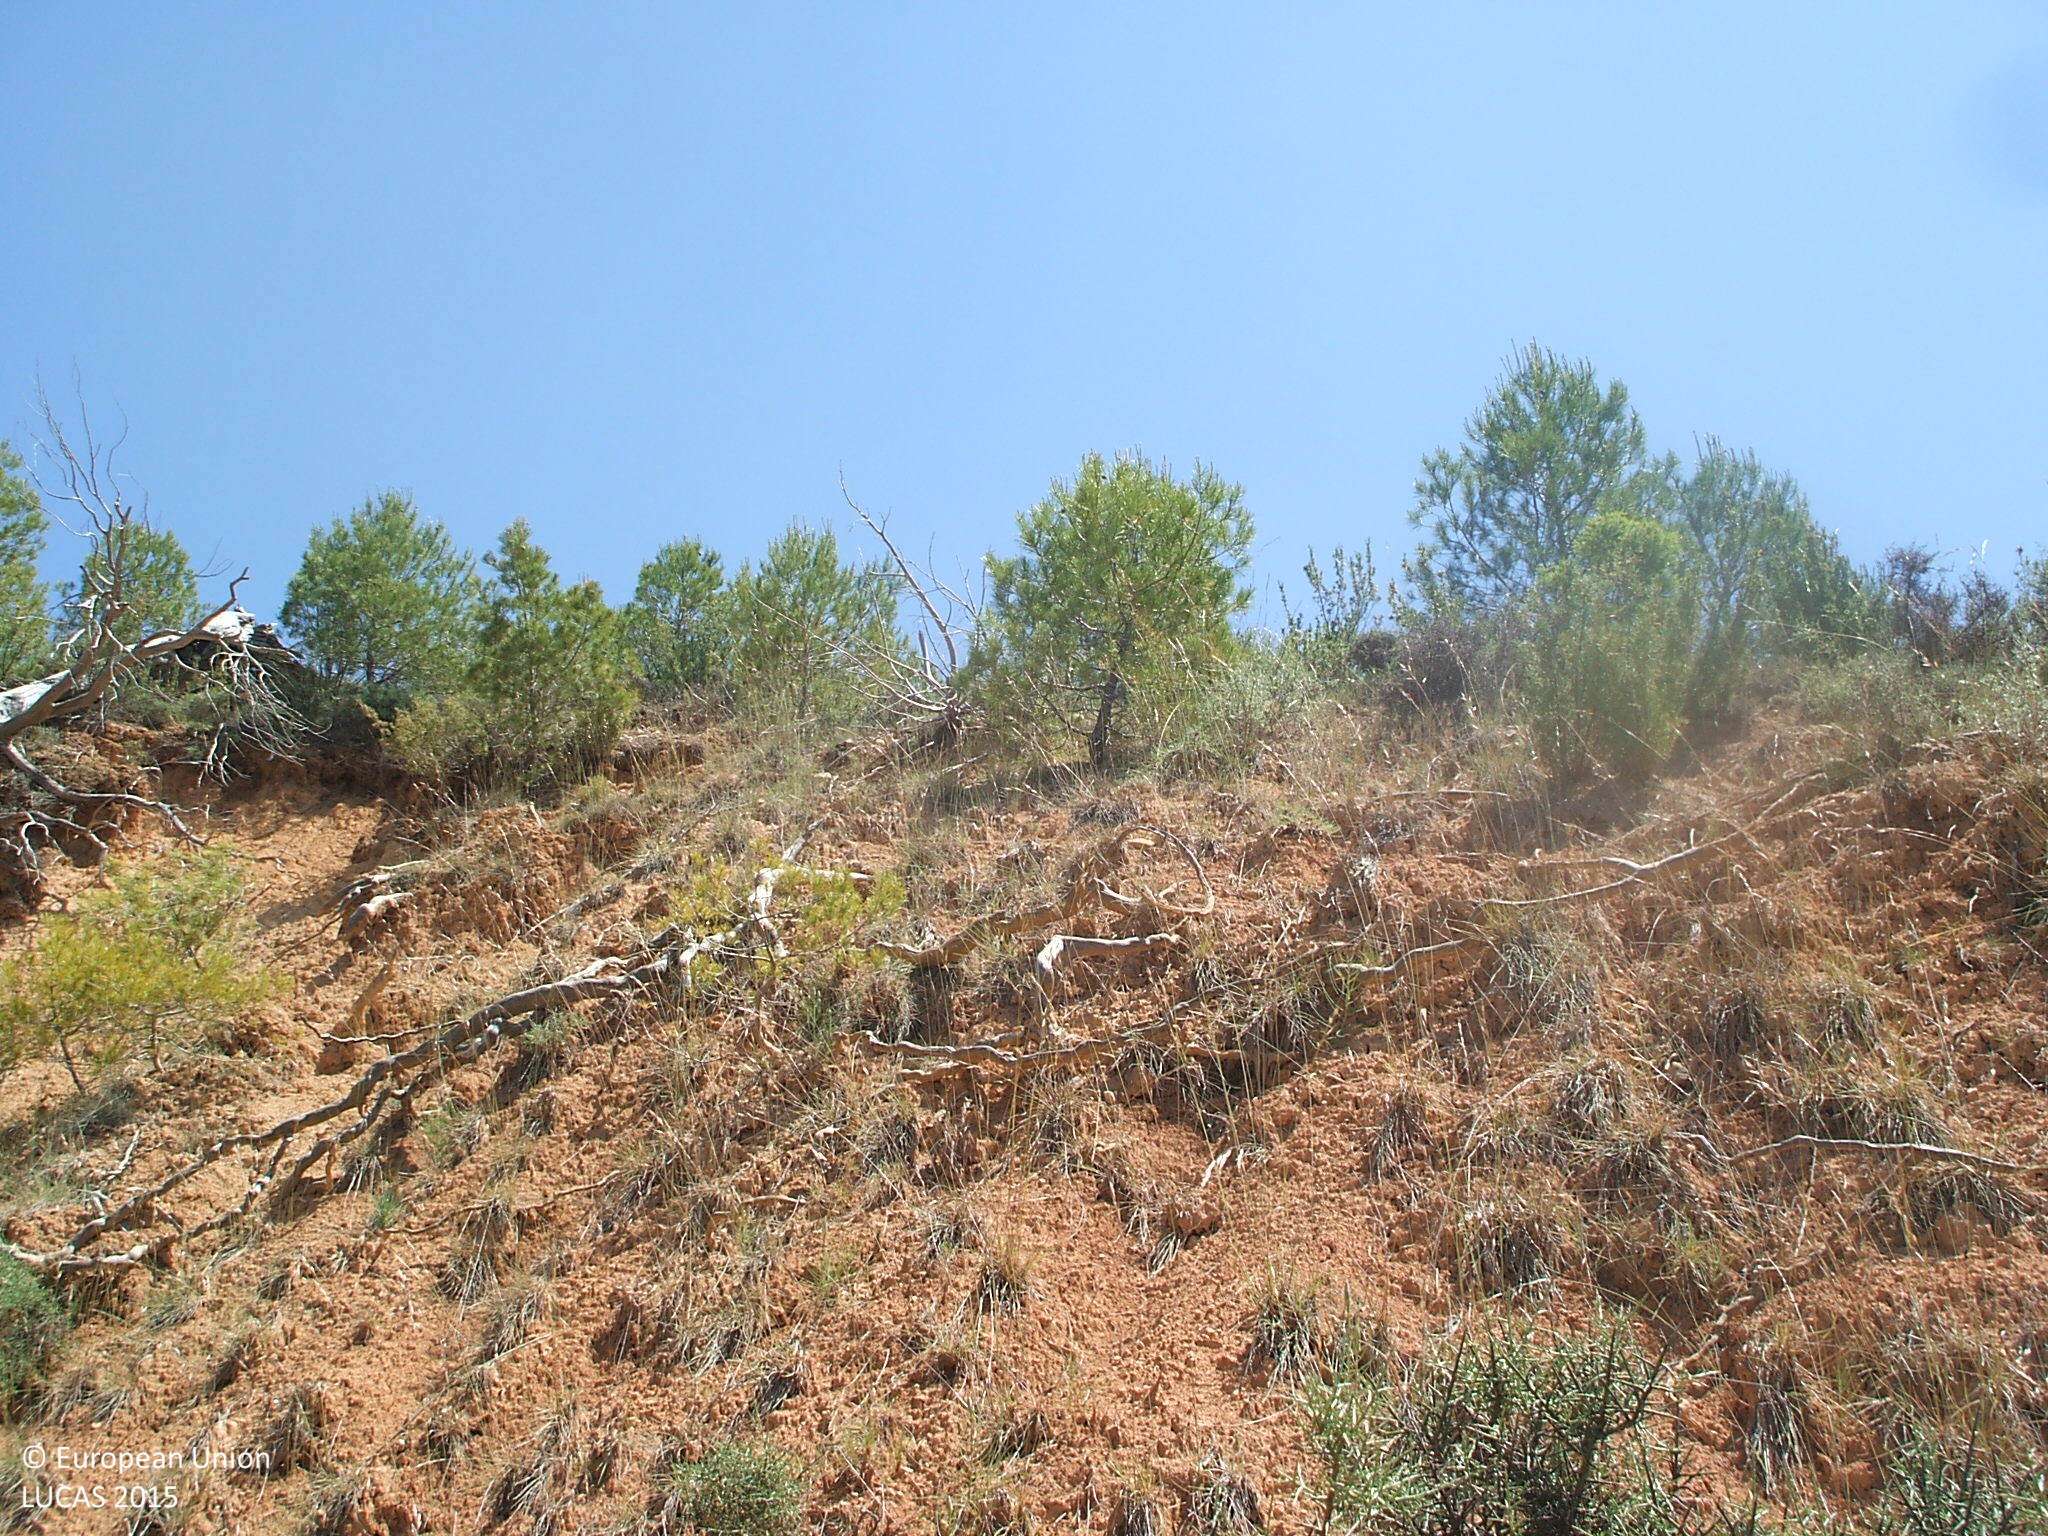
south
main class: Woodland
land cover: Pine dominated coniferous woodland
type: coniferous forest of the mediterranean region
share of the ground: 25 - 50 %
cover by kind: shrubs 50 %, coniferous forest trees 40 %, consolidated bare surface 10 %
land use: Semi-natural and natural areas not in use
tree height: > 5 m
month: May
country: ES
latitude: 40.7049
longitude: -0.1517
